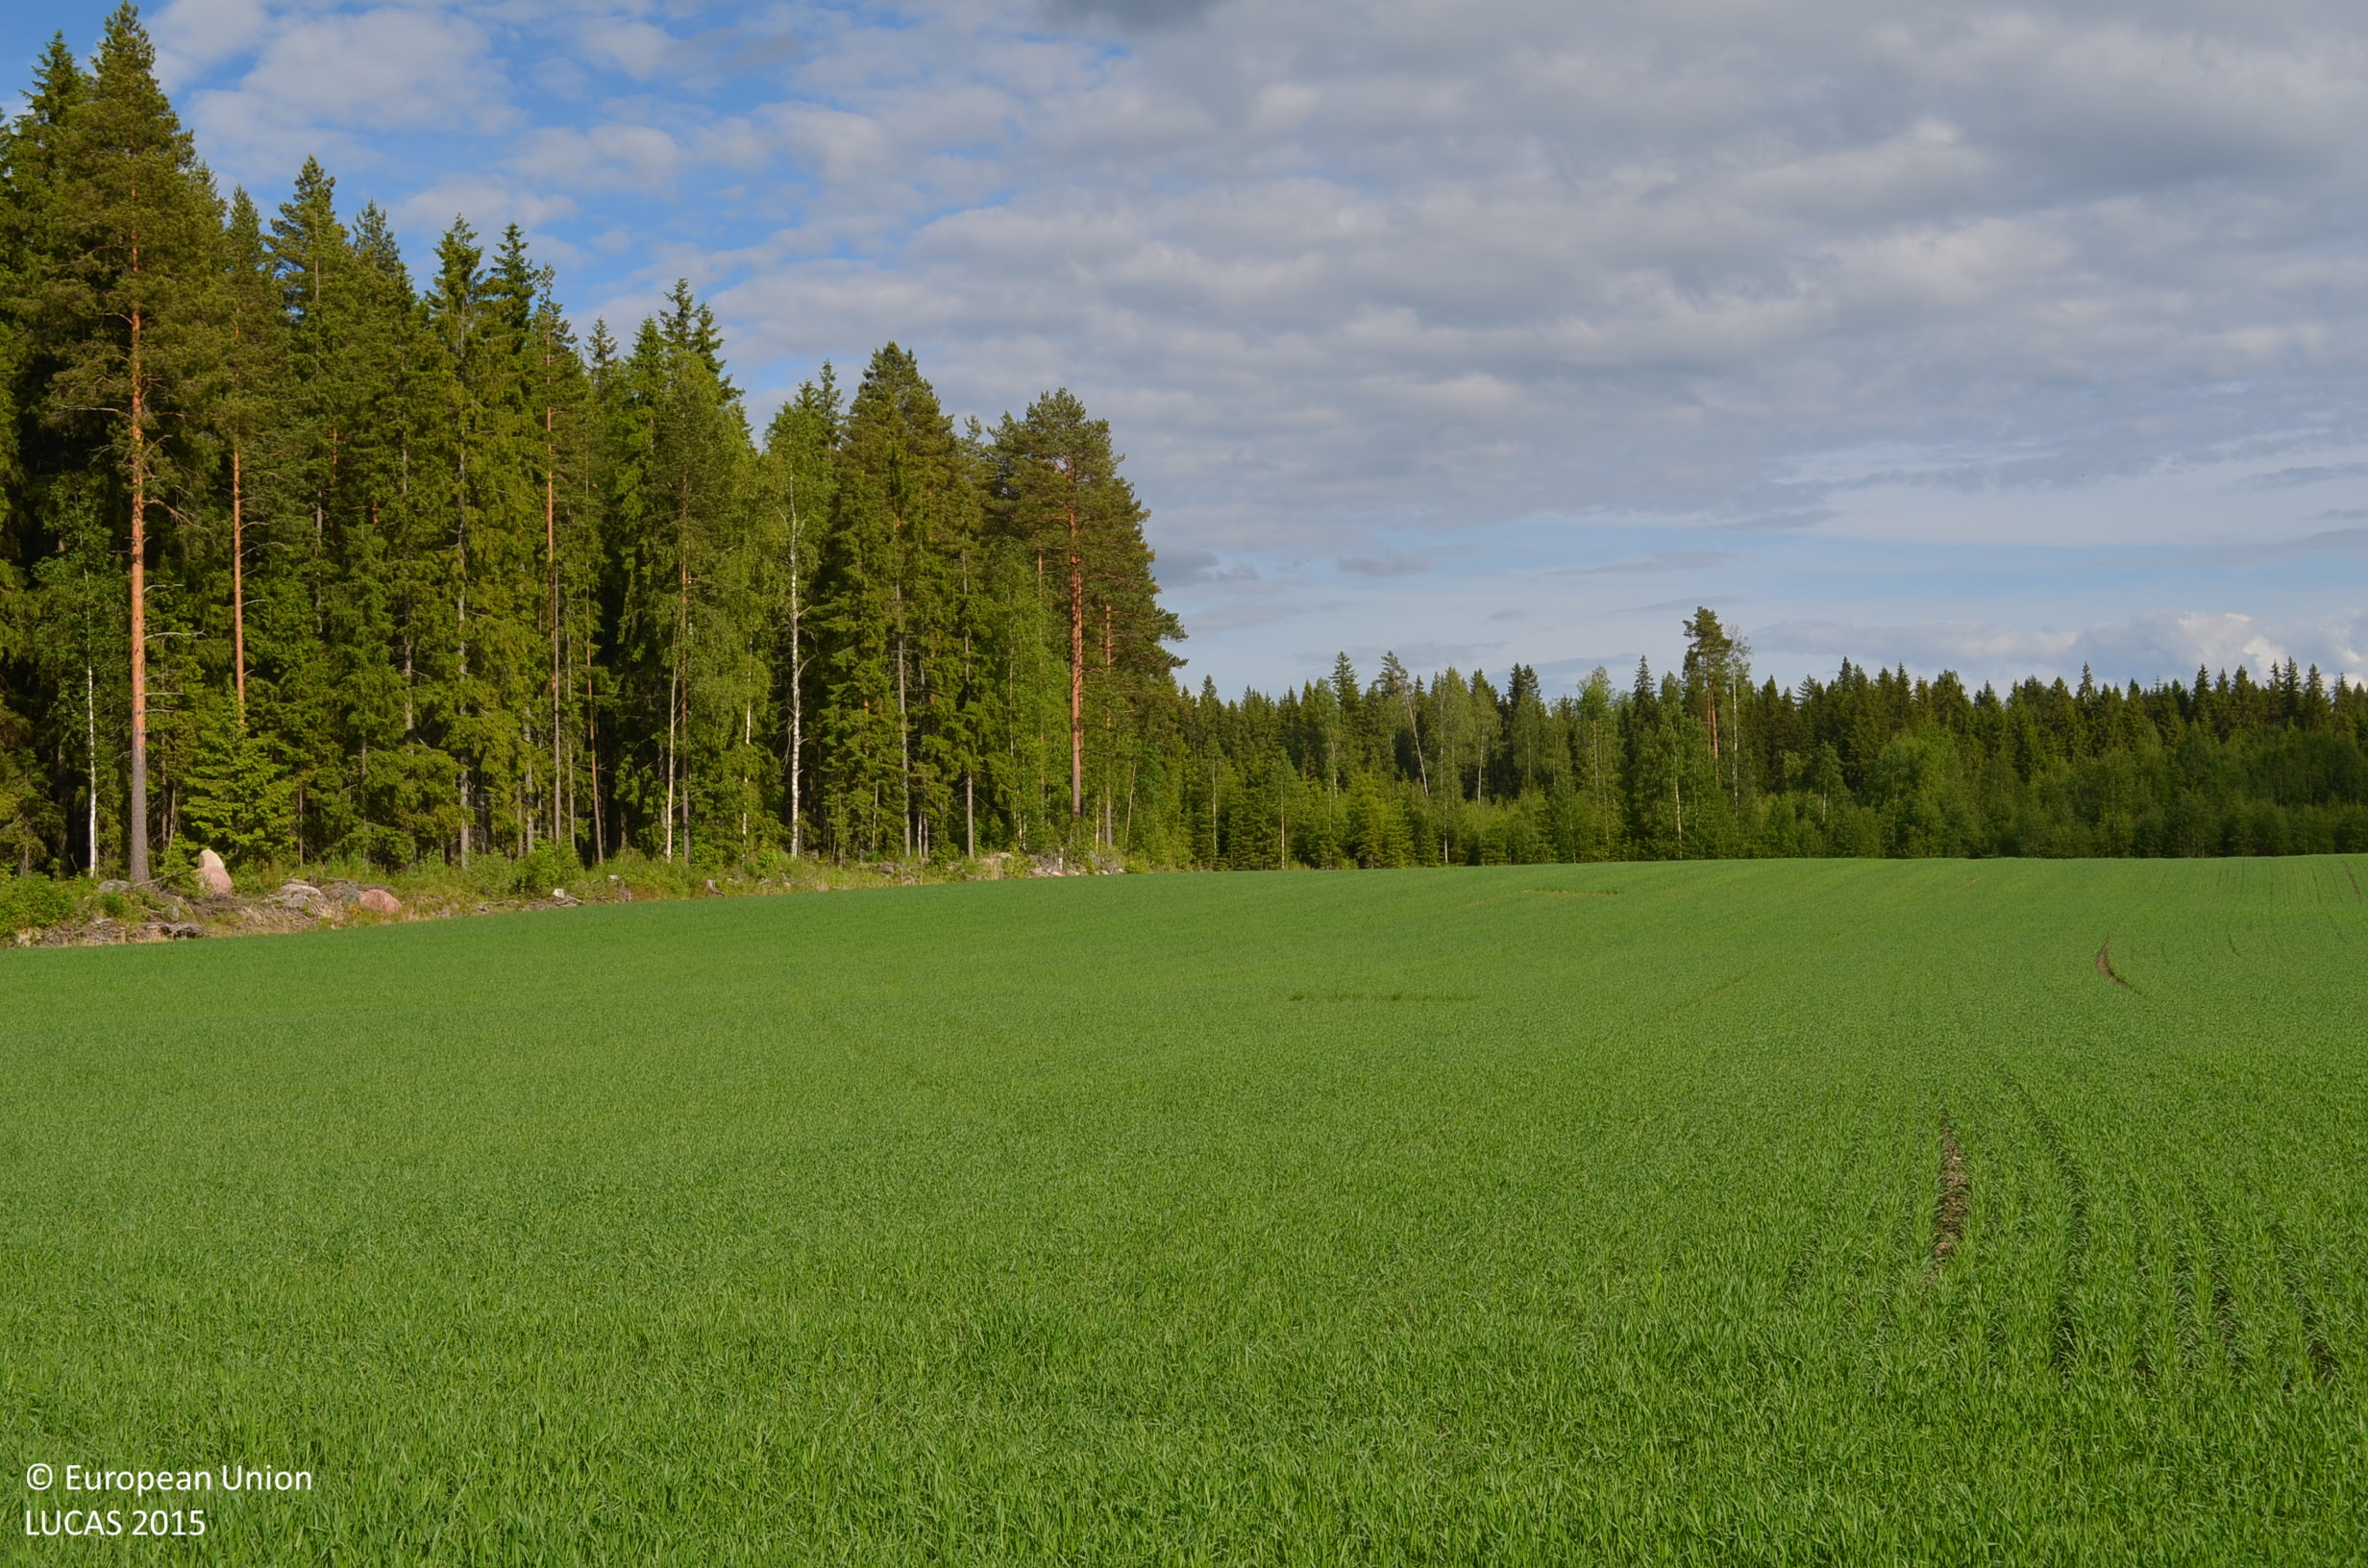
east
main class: Cropland
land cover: Oats
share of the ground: > 75 %
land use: Agriculture (excluding fallow land and kitchen gardens)
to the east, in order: Oats; Grass margins; Ditches and canals; Abandoned hedges; Spruce dominated coniferous woodland; Ditches and canals; Spruce dominated coniferous woodland; Tracks; Ditches and canals; Spruce dominated coniferous woodland; Ditches and canals; Other mixed woodland; Spruce dominated mixed woodland
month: June
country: FI
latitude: 61.8171
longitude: 23.3026
